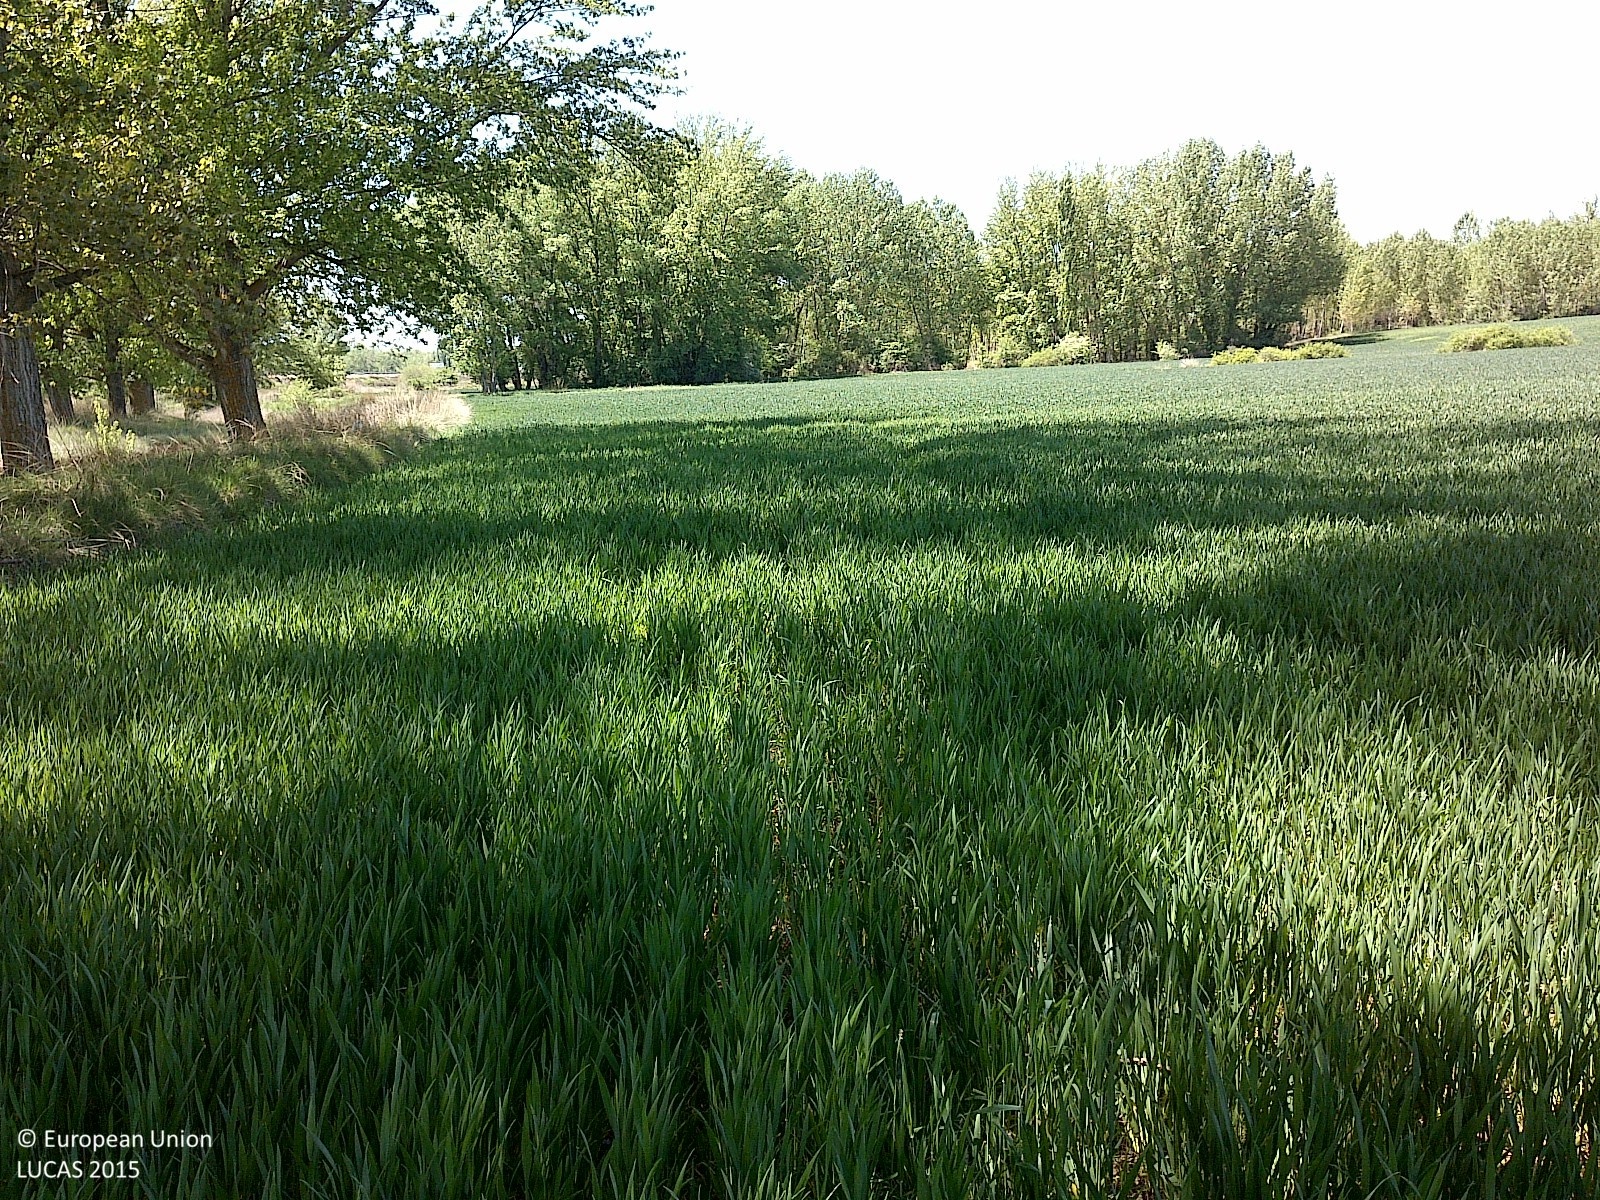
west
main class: Cropland
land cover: Barley
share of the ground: > 75 %
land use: Agriculture (excluding fallow land and kitchen gardens)
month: May
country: ES
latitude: 41.5812
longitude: -3.2273
